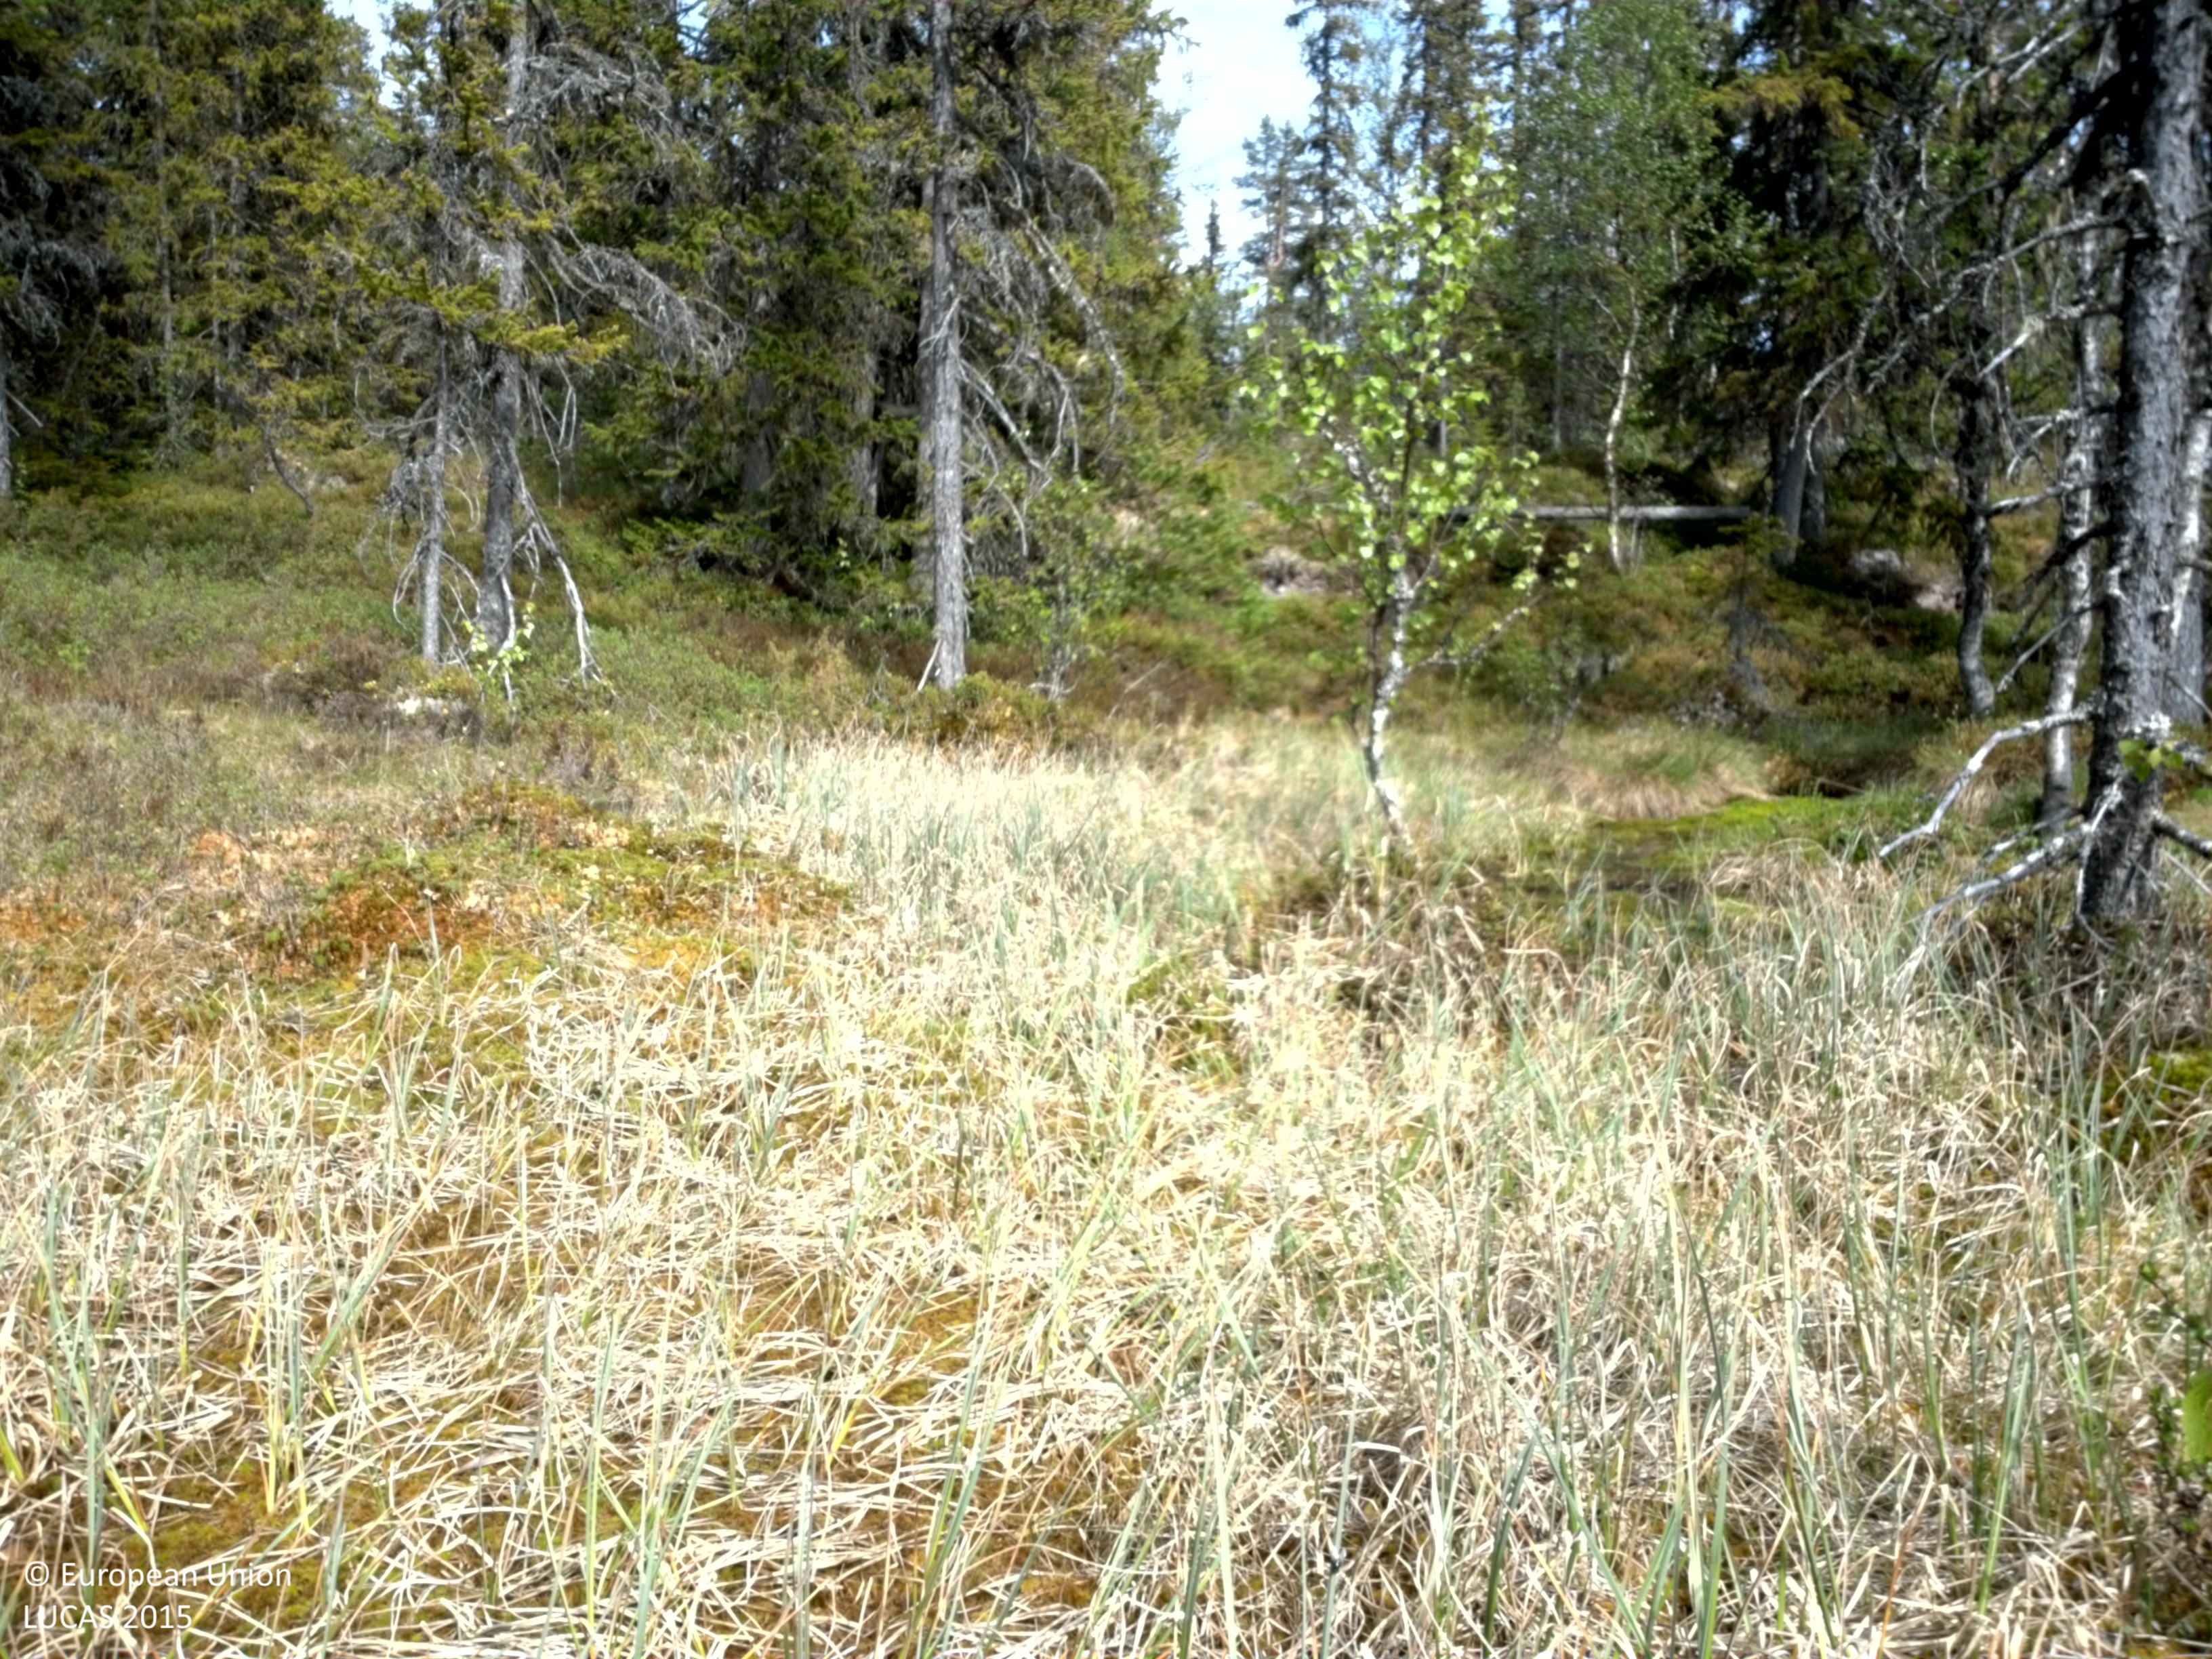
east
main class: Woodland
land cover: Pine dominated mixed woodland
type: boreal forest
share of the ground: 10 - 25 %
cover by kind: herbaceous plants 35 %, lichens and mosses 35 %, coniferous forest trees 15 %, broadleaved forest trees 10 %, shrubs 5 %
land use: Forestry
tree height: > 5 m
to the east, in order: Pine dominated mixed woodland; Spruce dominated coniferous woodland; Spruce dominated mixed woodland; Spruce dominated coniferous woodland; Tracks; Spruce dominated coniferous woodland; Pine dominated coniferous woodland
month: June
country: SE
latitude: 61.9352
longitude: 13.7010
